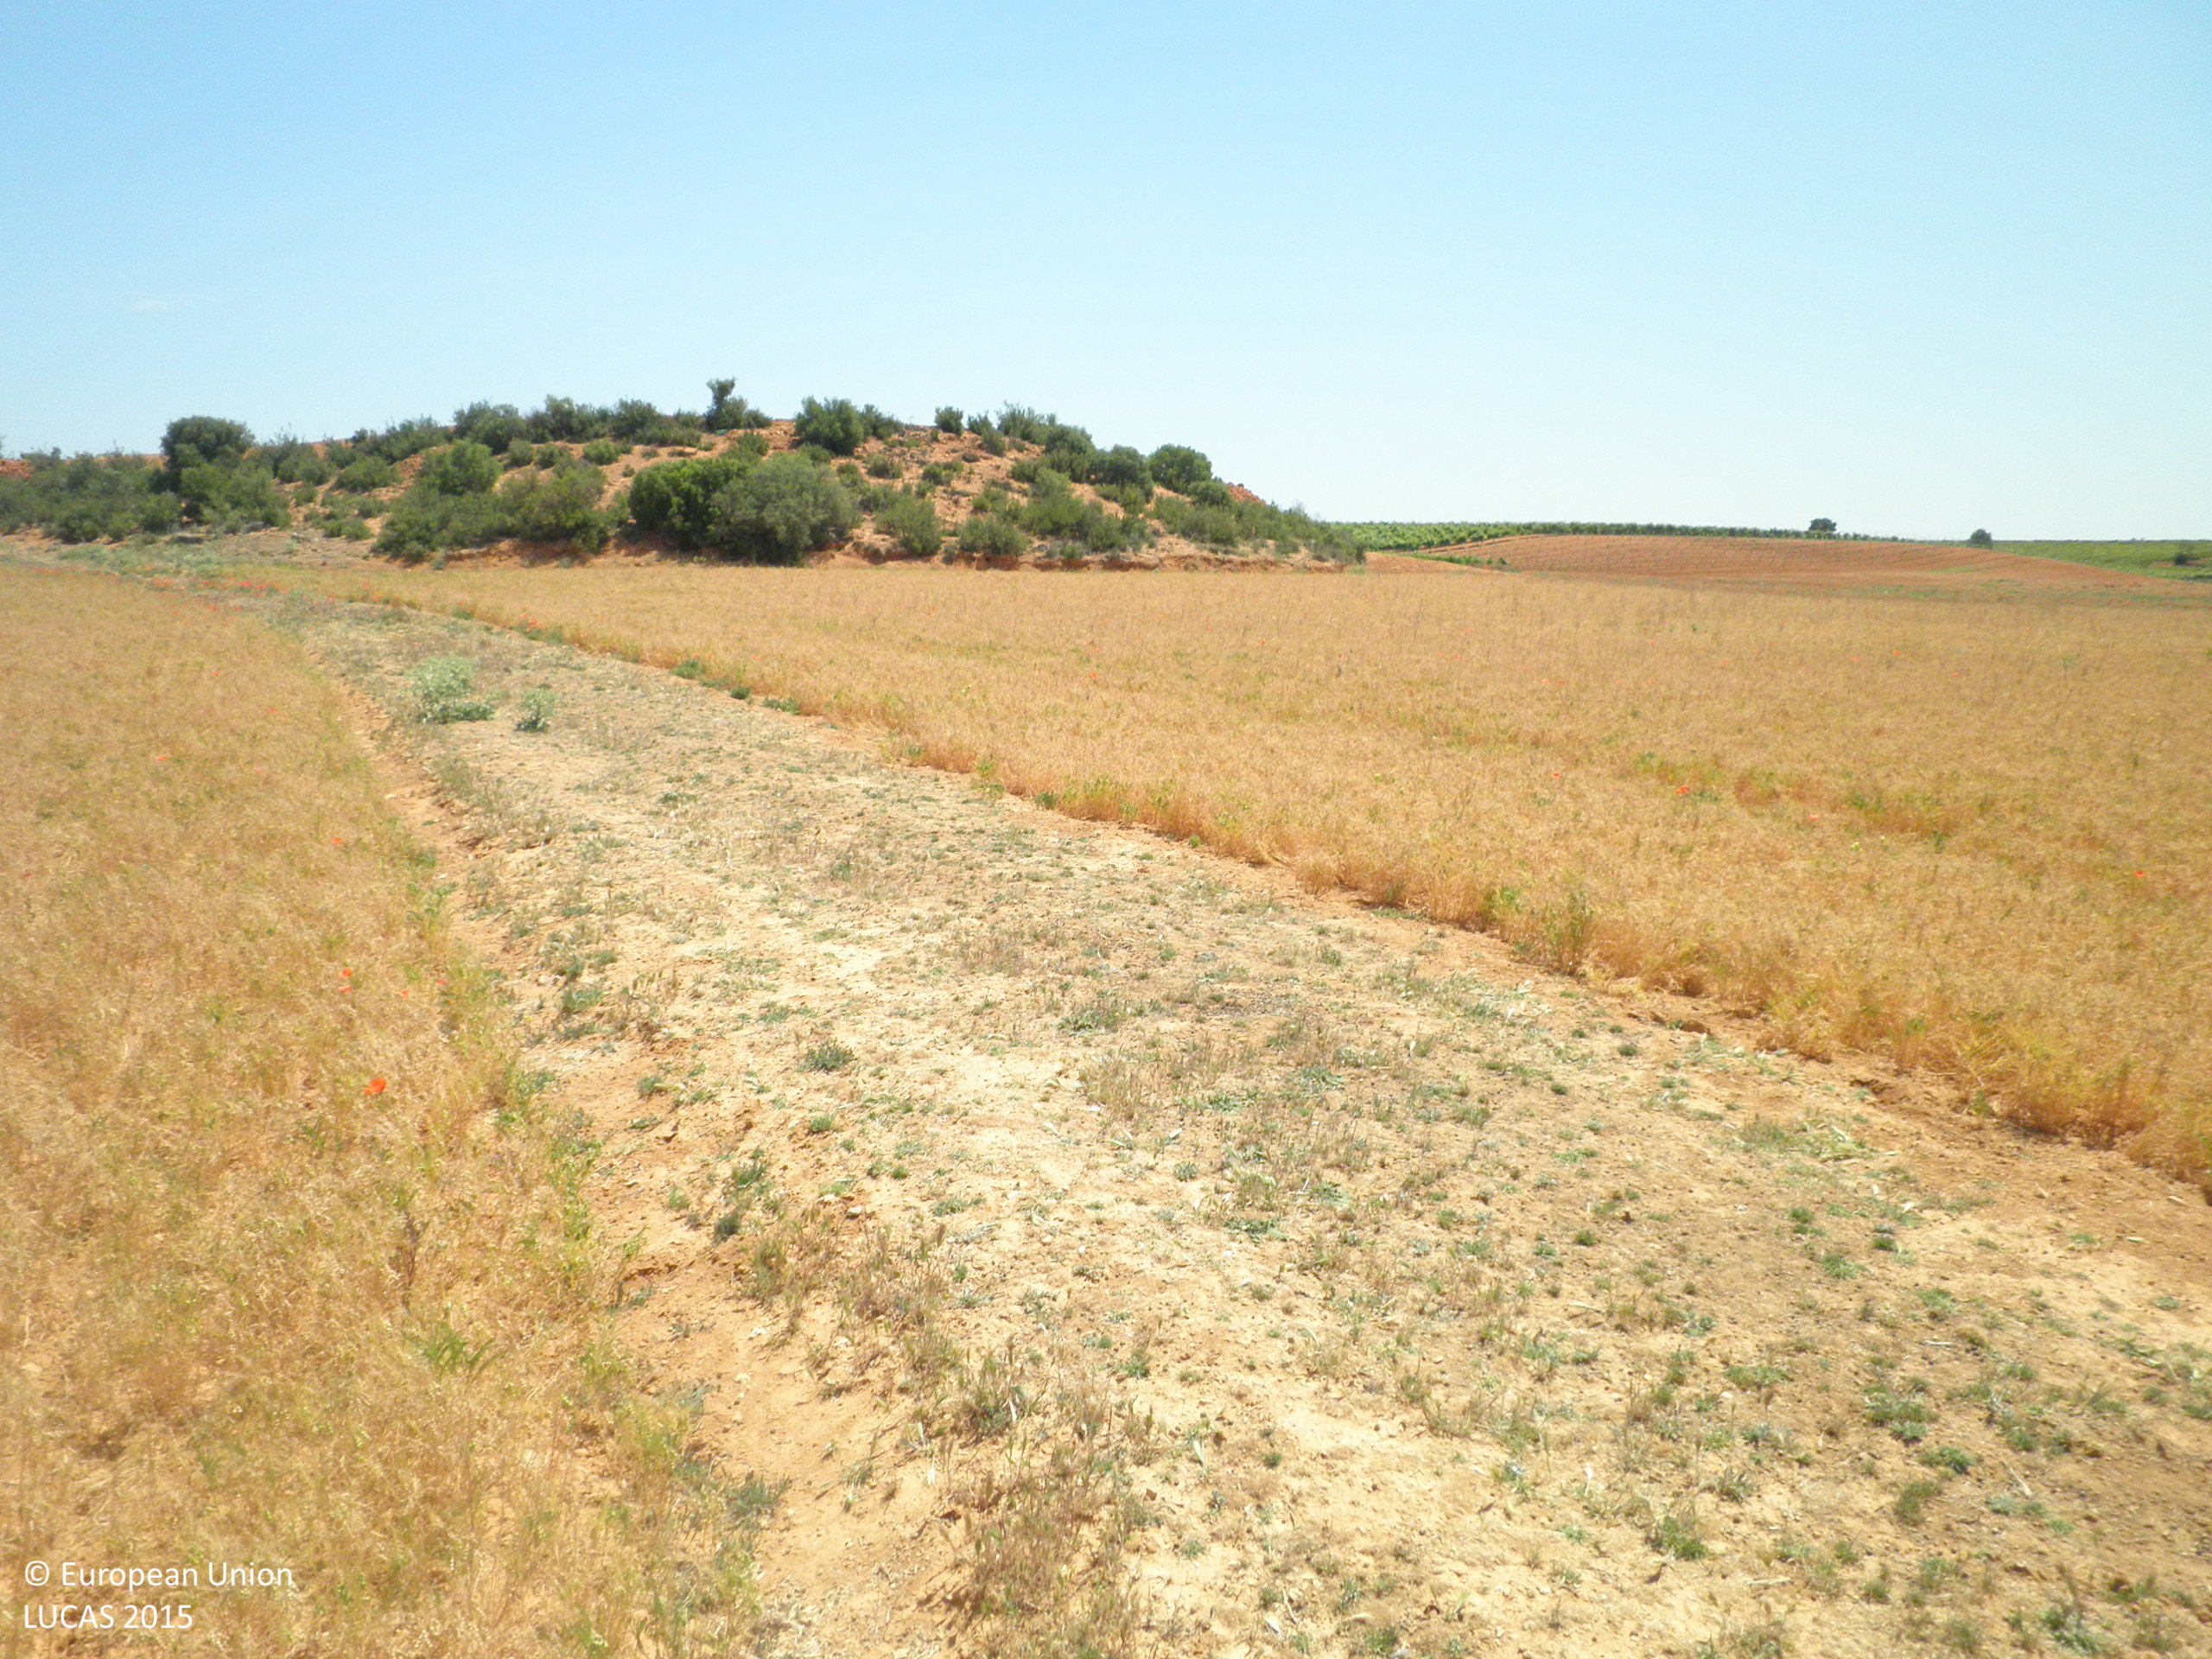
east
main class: Cropland
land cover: Dry pulses
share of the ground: > 75 %
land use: Agriculture (excluding fallow land and kitchen gardens)
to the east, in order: Dry pulses; Tracks; Dry pulses; Shrubland without tree cover; Spontaneously vegetated surfaces; Fences; Vineyards
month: June
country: ES
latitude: 39.4224
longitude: -1.8189
